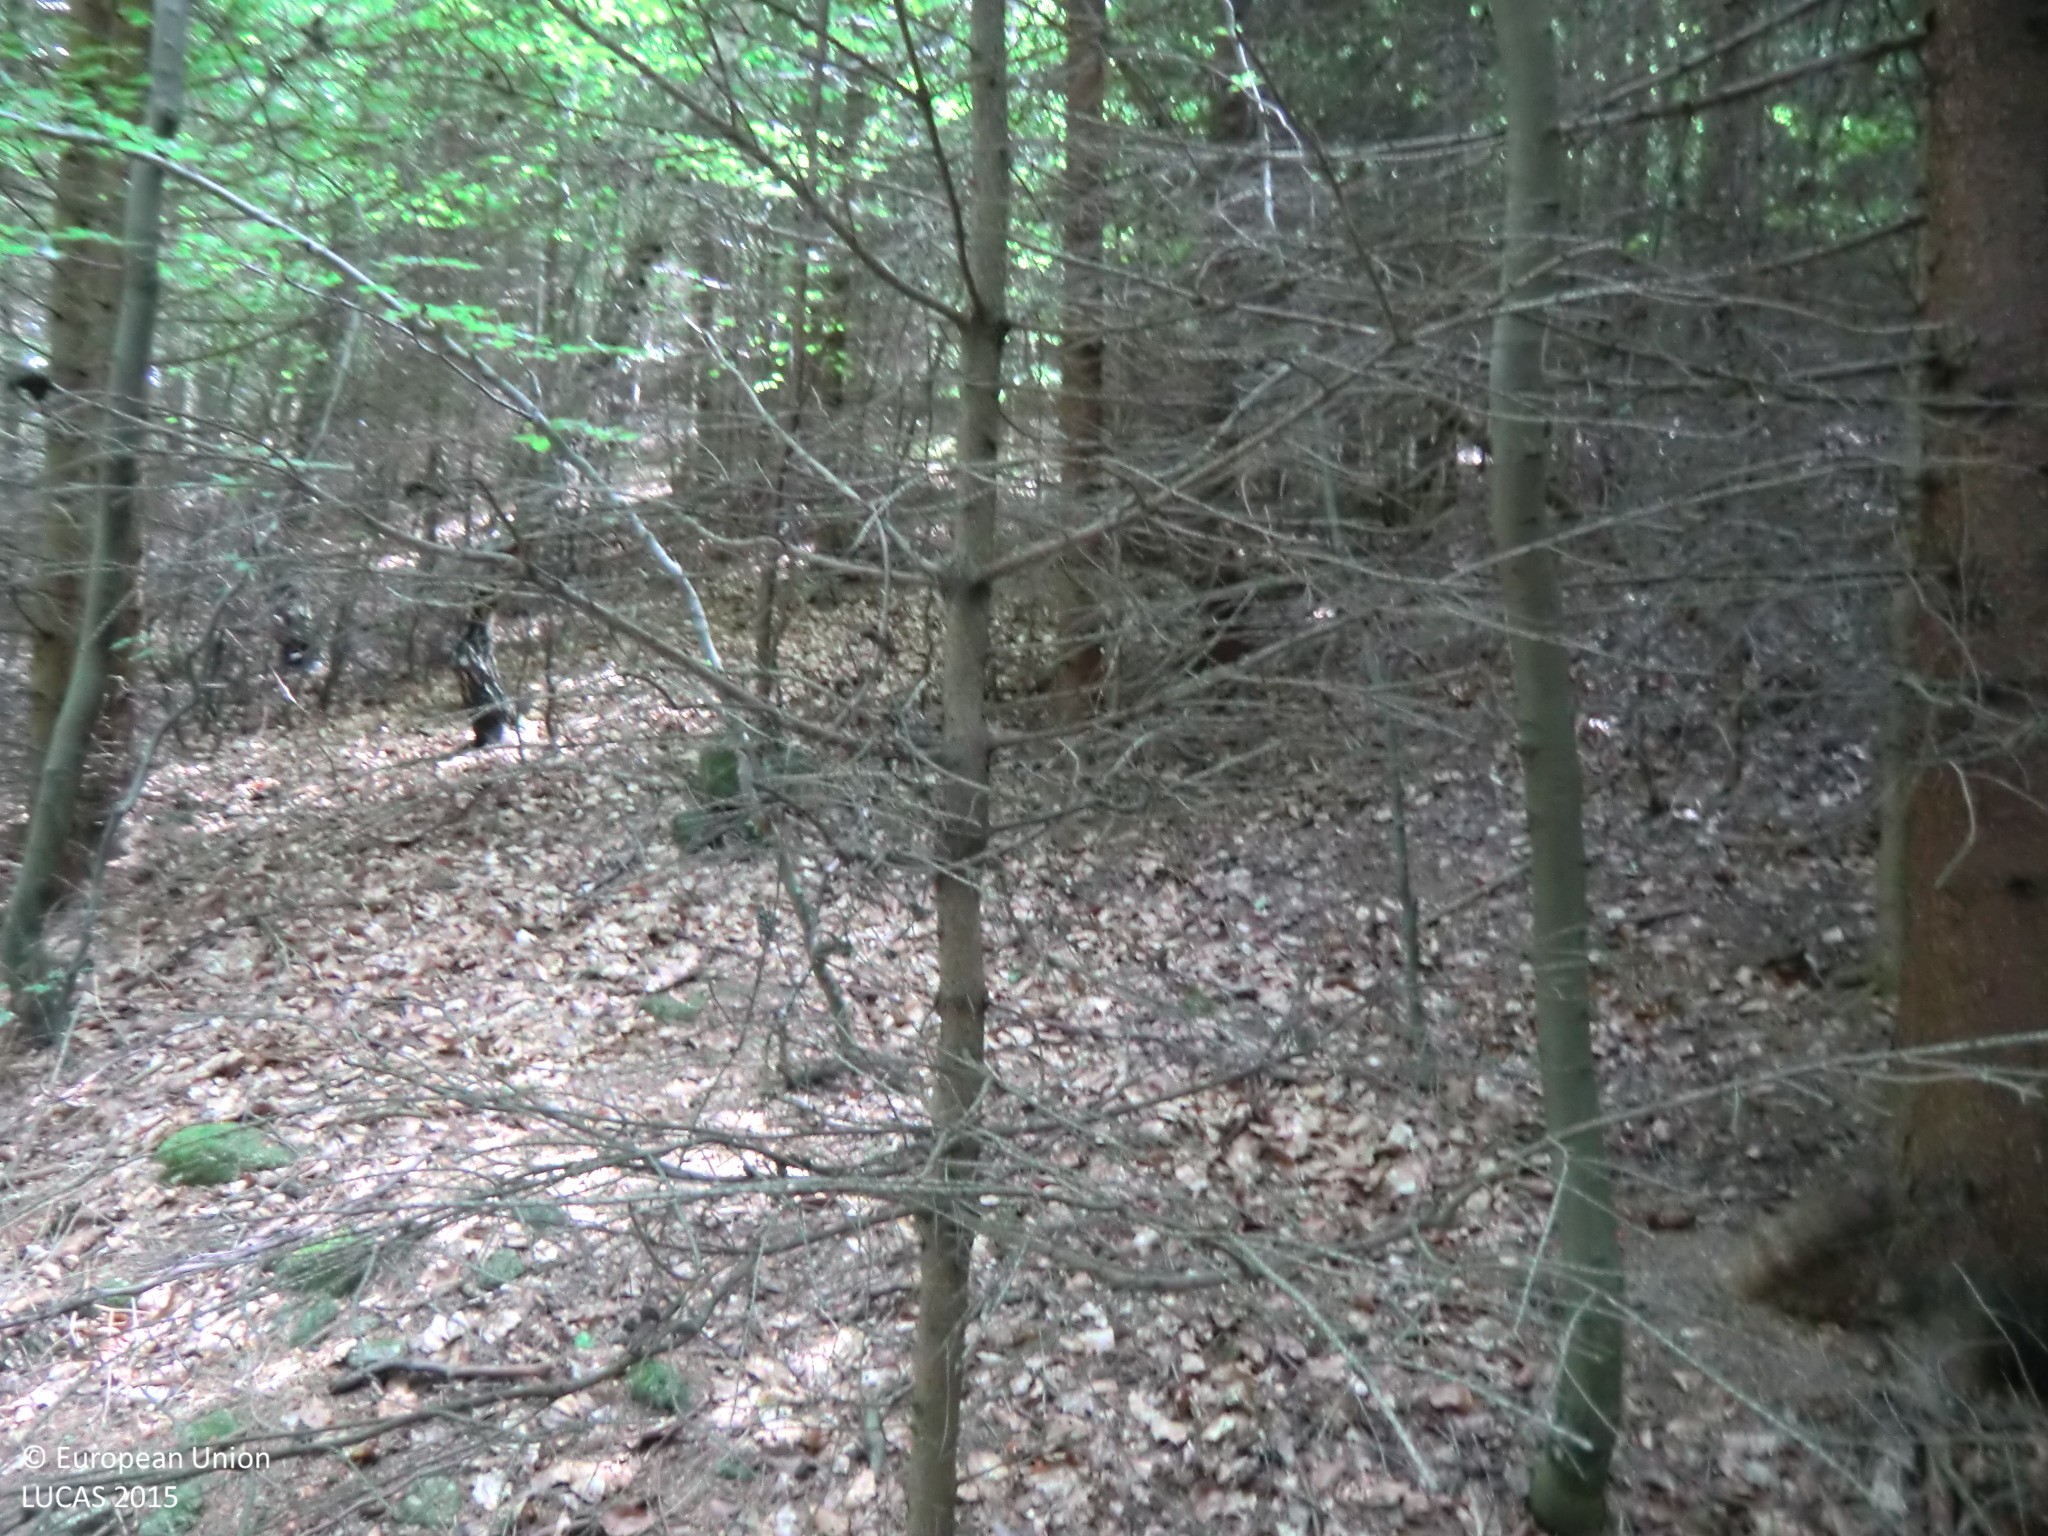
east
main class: Woodland
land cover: Spruce dominated mixed woodland
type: hemiboreal forest and nemoral coniferous forest and mixed broadleaved-coniferous forest
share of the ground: > 75 %
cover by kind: coniferous forest trees 65 %, broadleaved forest trees 25 %, unconsolidated bare surface 10 %
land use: Forestry
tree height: > 5 m
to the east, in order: Spruce dominated mixed woodland; Grassland without tree/shrub cover; Electric lines; Grassland without tree/shrub cover; Artificial constructions in urban areas; Grassland without tree/shrub cover
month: June
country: AT
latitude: 48.6146
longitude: 15.0070
